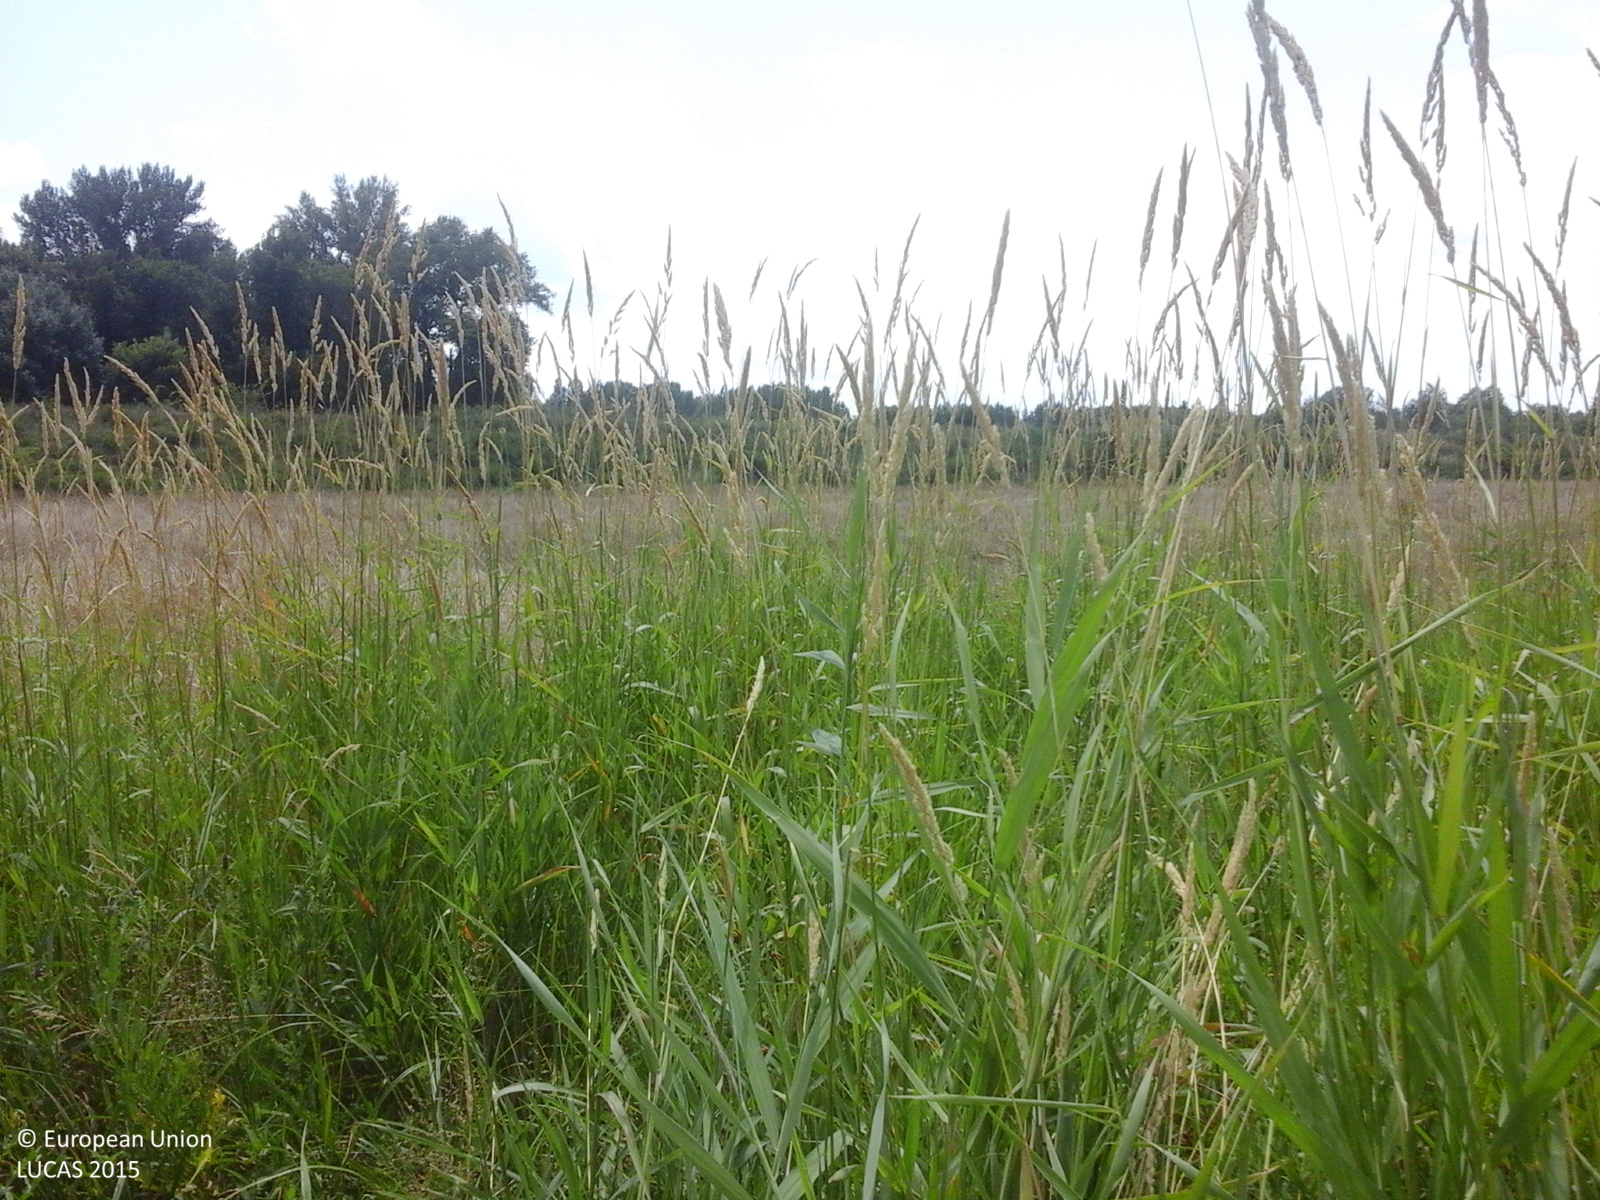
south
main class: Grassland
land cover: Spontaneously vegetated surfaces
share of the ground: > 75 %
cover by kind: herbaceous plants 100 %
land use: Fallow land
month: June
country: RO
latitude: 44.0617
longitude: 26.5279
